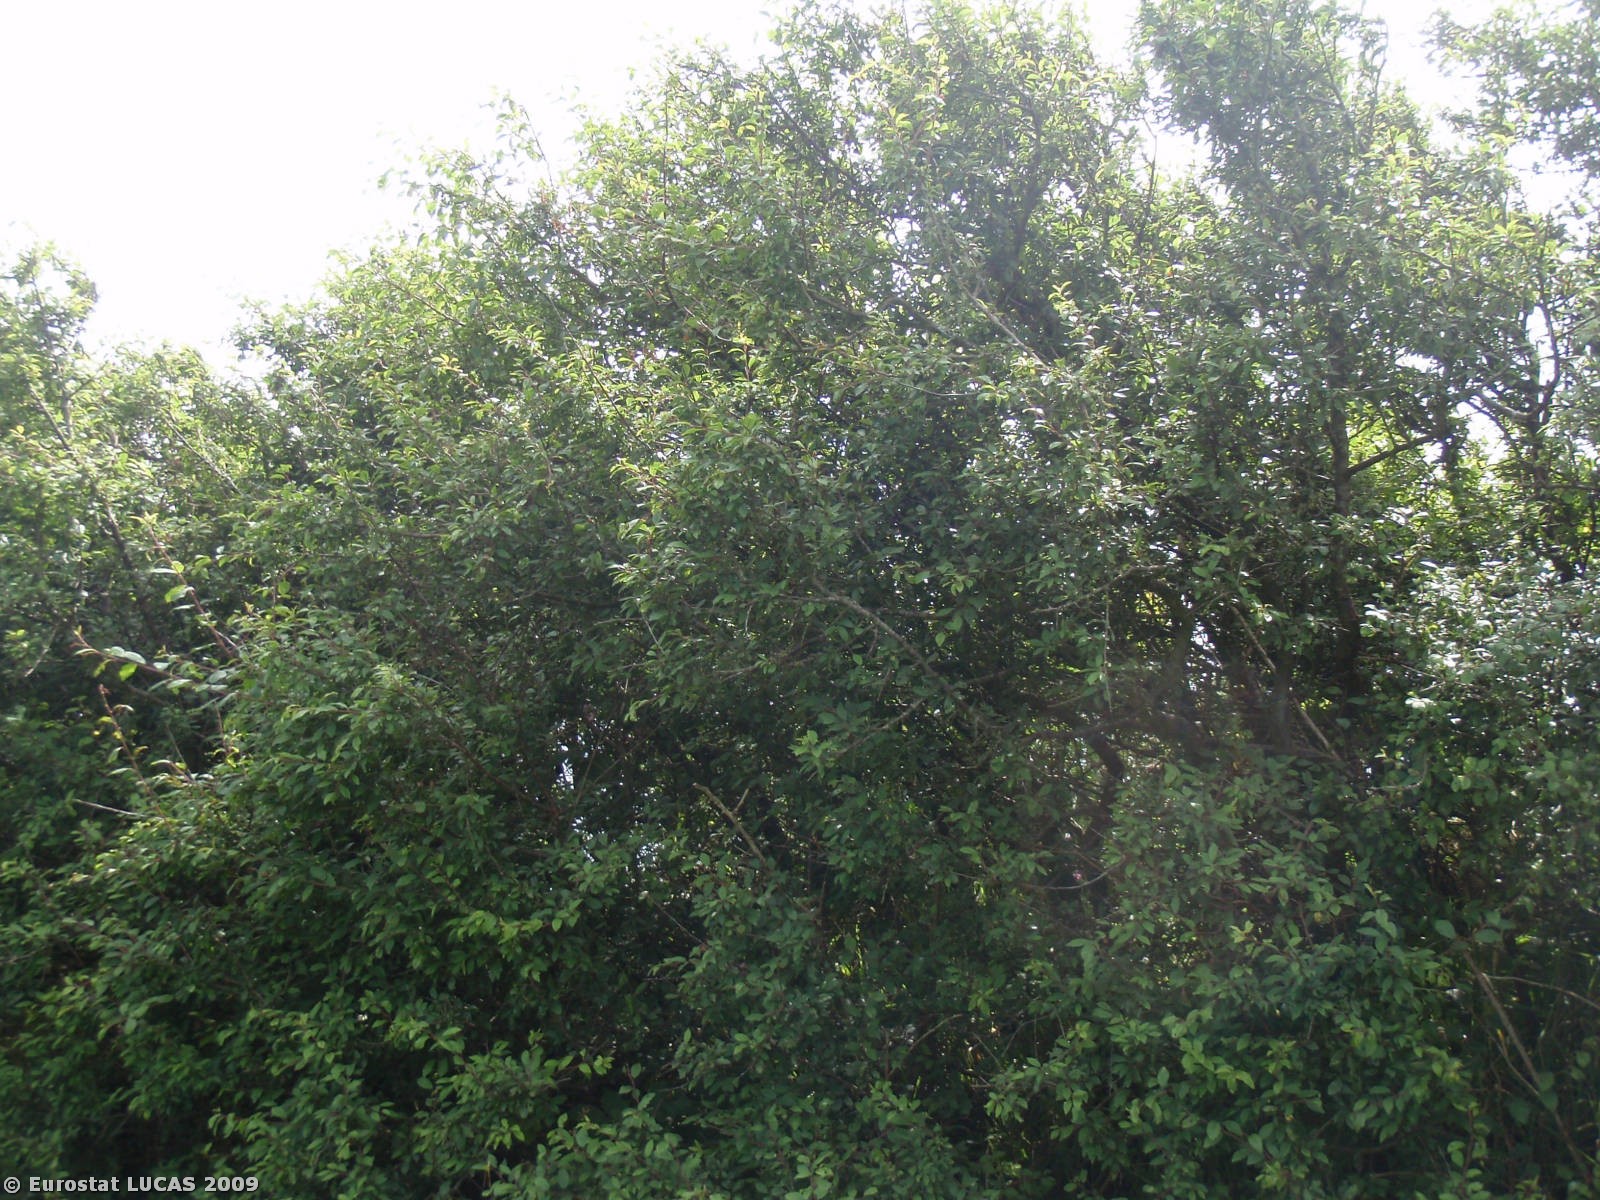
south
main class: Grassland
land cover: Grassland without tree/shrub cover
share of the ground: > 75 %
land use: Agriculture (excluding fallow land and kitchen gardens)
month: August
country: GB
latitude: 50.6379
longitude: -4.6579
